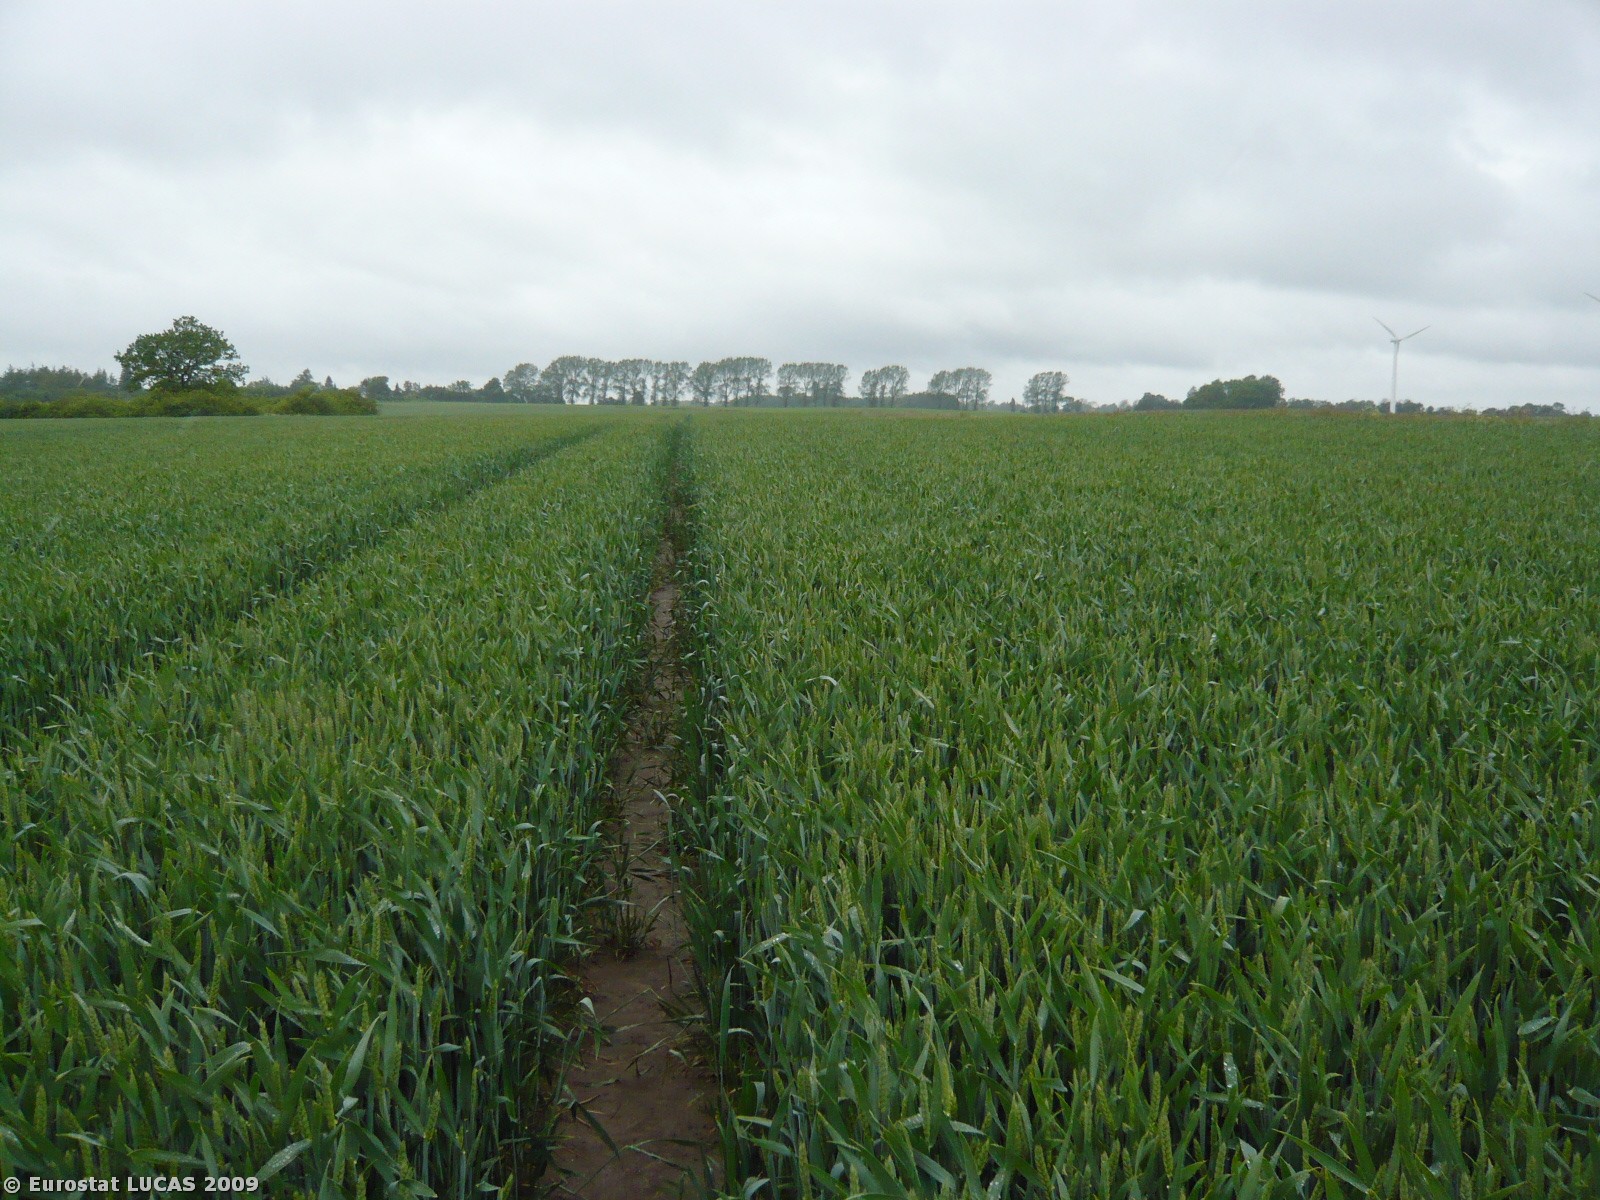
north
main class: Cropland
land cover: Common wheat
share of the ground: > 75 %
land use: Agriculture (excluding fallow land and kitchen gardens)
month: June
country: DK
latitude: 54.7707
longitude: 11.9418
